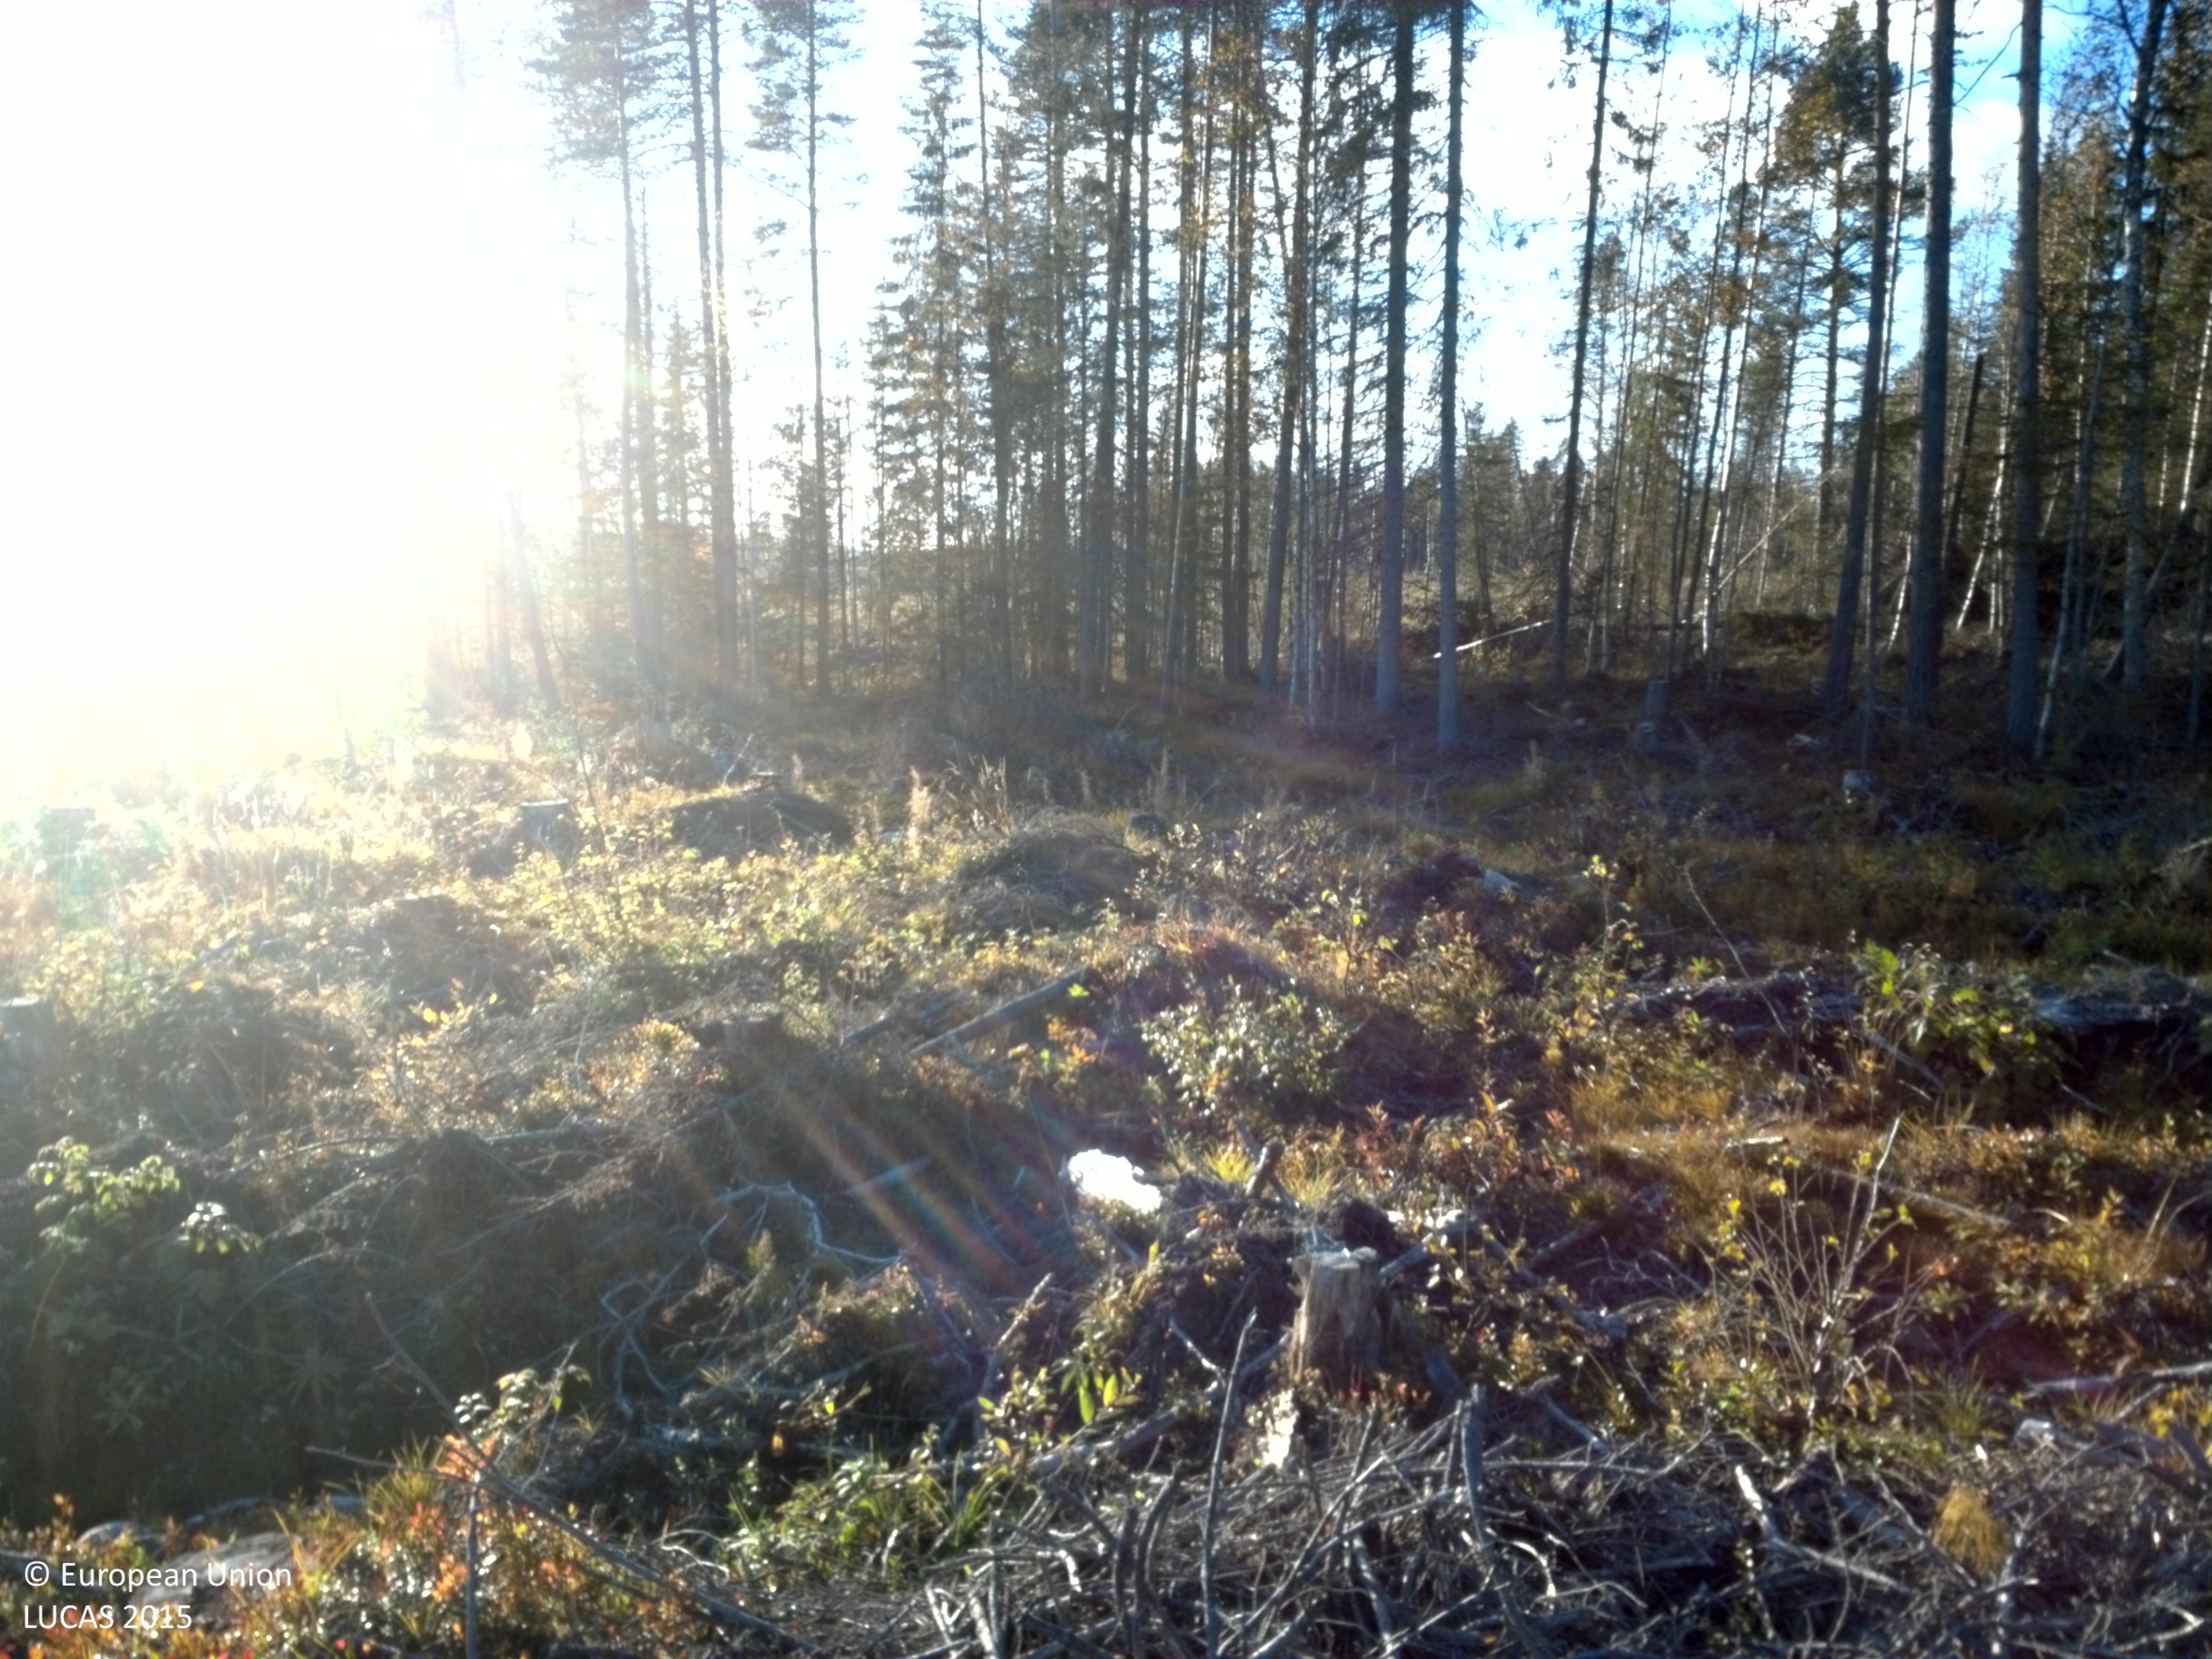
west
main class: Shrubland
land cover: Shrubland with sparse tree cover
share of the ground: 25 - 50 %
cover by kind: shrubs 35 %, herbaceous plants 30 %, unconsolidated bare surface 10 %, broadleaved forest trees 5 %, lichens and mosses 5 %, consolidated bare surface 5 %
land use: Forestry
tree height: < 5 m
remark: Clear cut
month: September
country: SE
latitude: 64.9800
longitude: 17.5712
